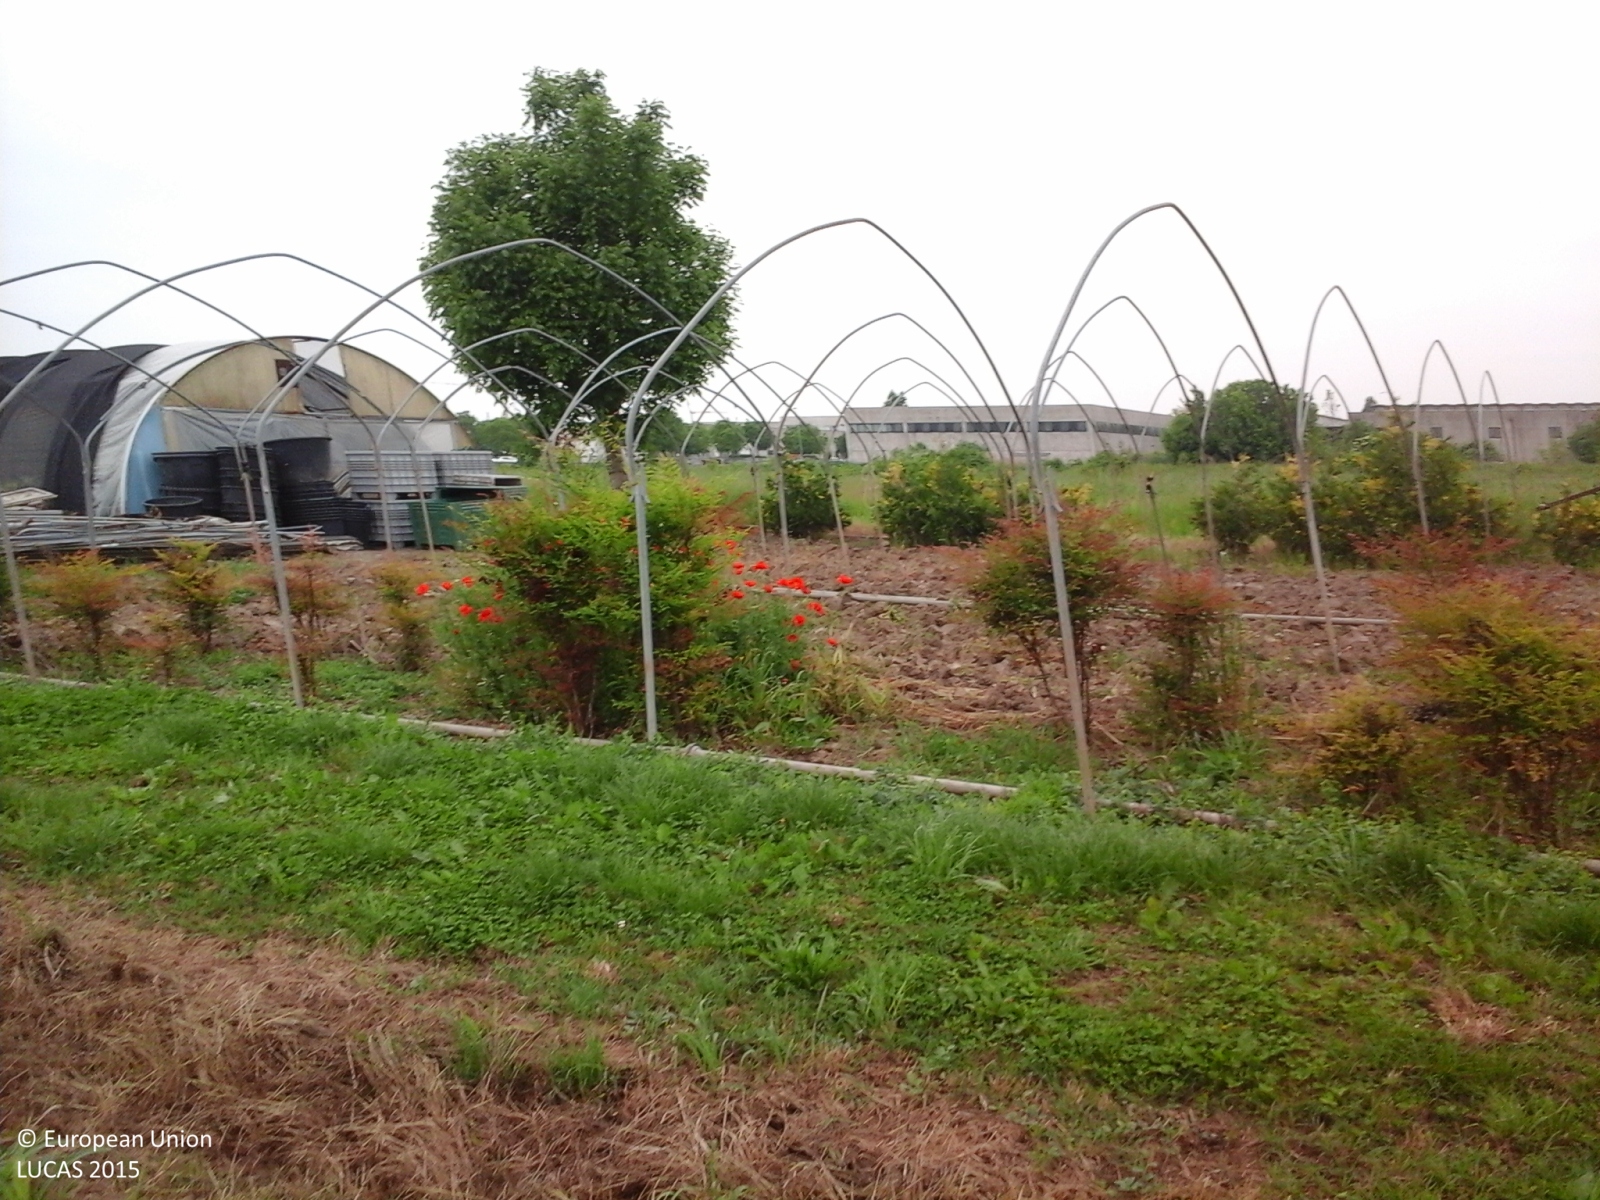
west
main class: Cropland
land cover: Maize
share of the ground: 10 - 25 %
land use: Agriculture (excluding fallow land and kitchen gardens)
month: May
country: IT
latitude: 45.2205
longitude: 11.6907
